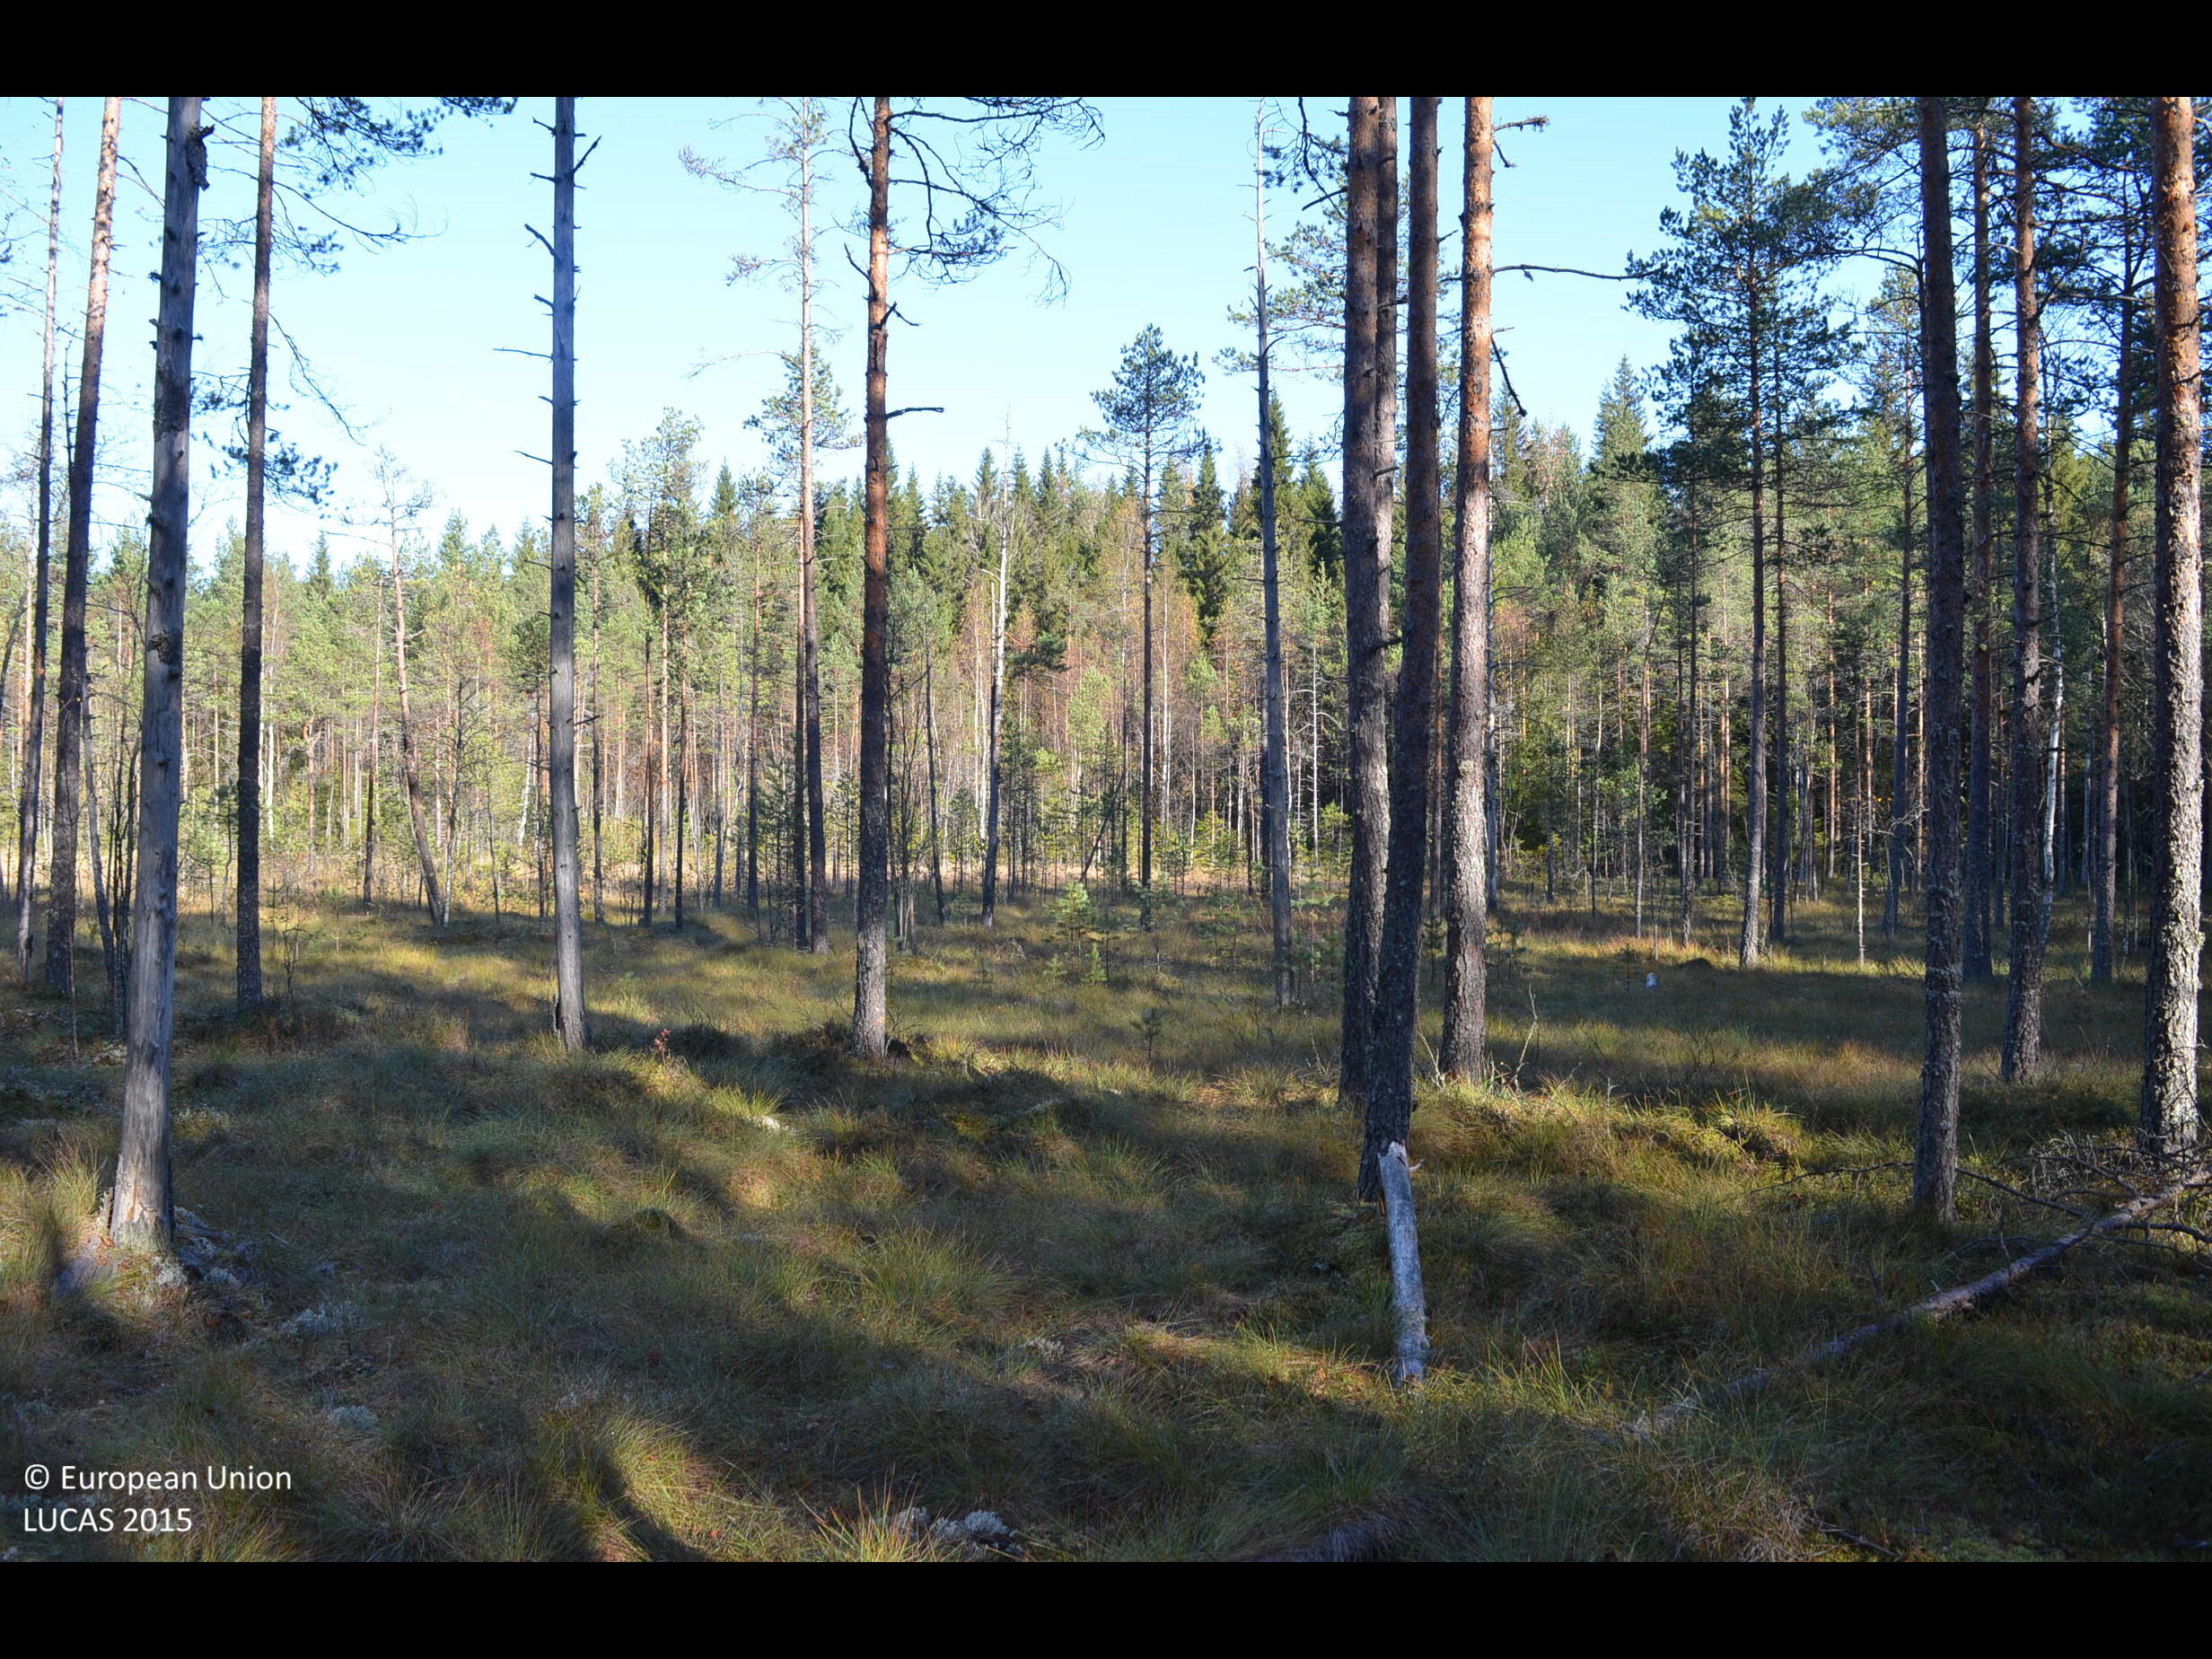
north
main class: Woodland
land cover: Pine dominated coniferous woodland
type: boreal forest
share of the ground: 50 - 75 %
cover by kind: coniferous forest trees 60 %, shrubs 15 %, lichens and mosses 15 %, herbaceous plants 10 %
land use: Forestry
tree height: > 5 m
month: October
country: FI
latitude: 61.7935
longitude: 23.9490
